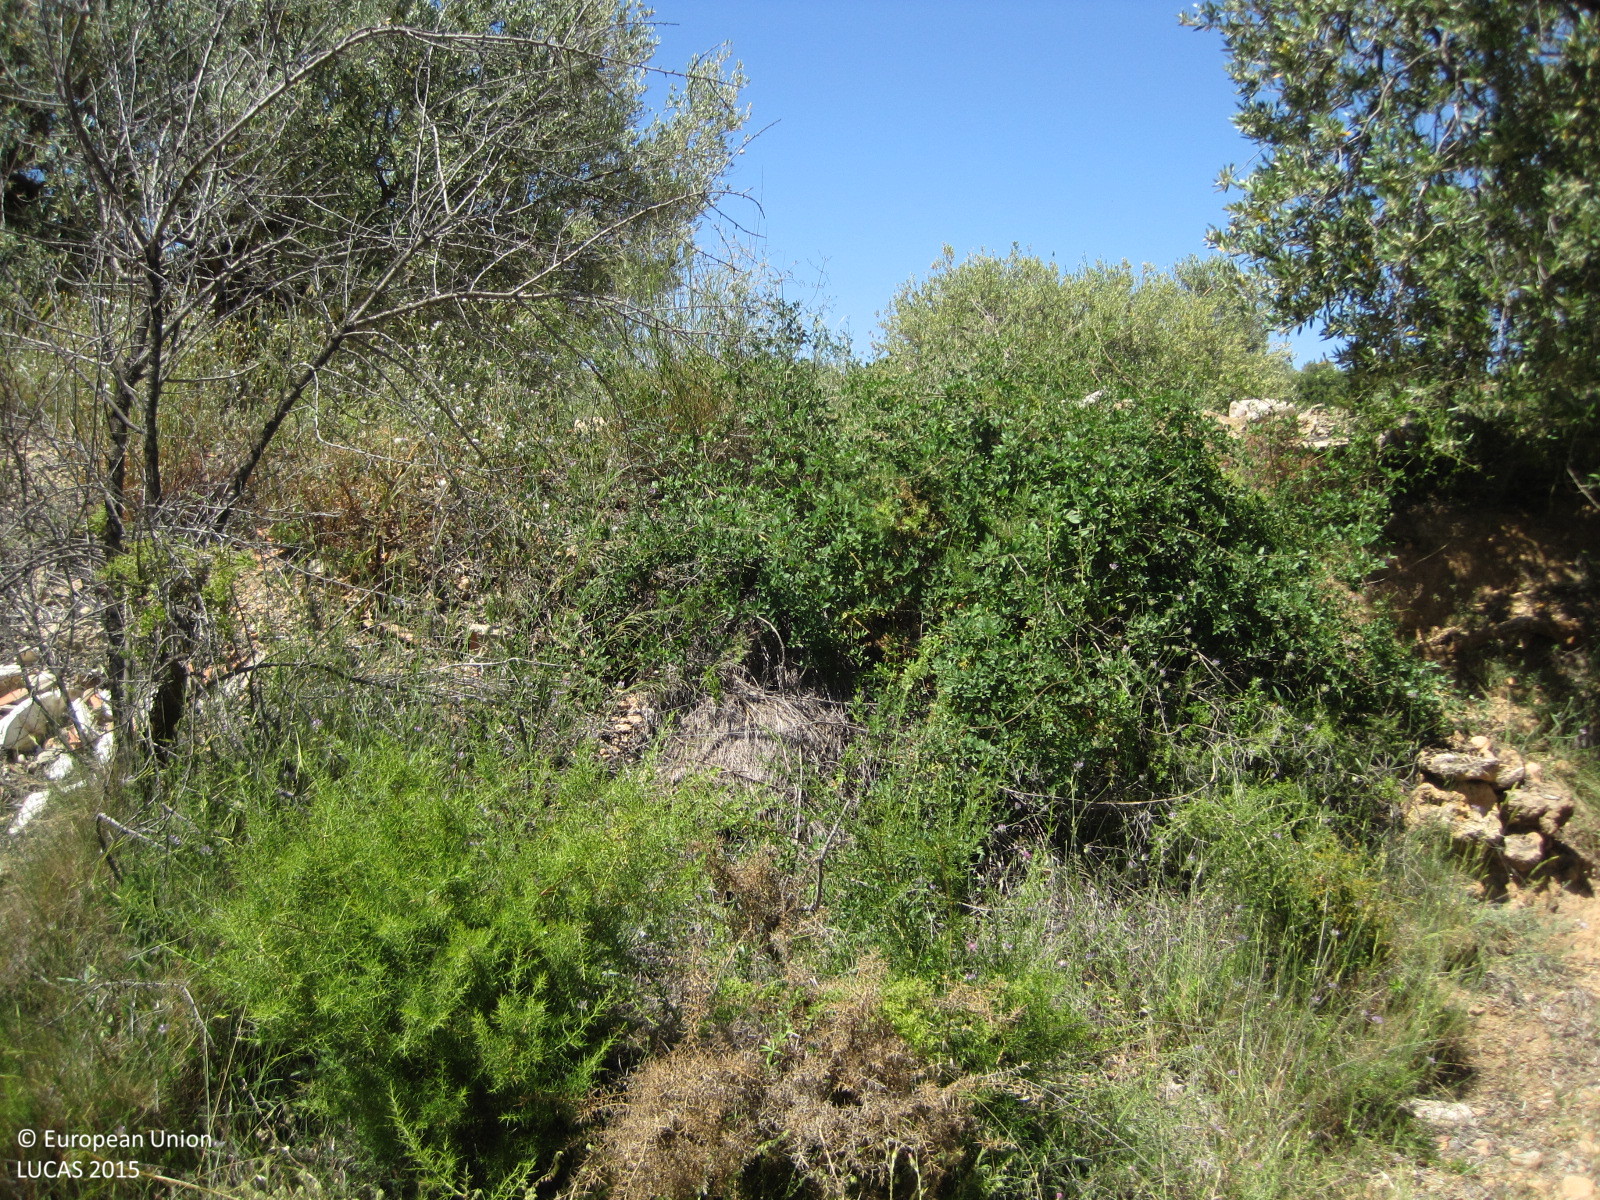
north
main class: Cropland
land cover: Permanent industrial crops
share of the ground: 10 - 25 %
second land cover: Spontaneously vegetated surfaces
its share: > 75 %
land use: Agriculture (excluding fallow land and kitchen gardens)
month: May
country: ES
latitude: 39.3768
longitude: -0.8059
